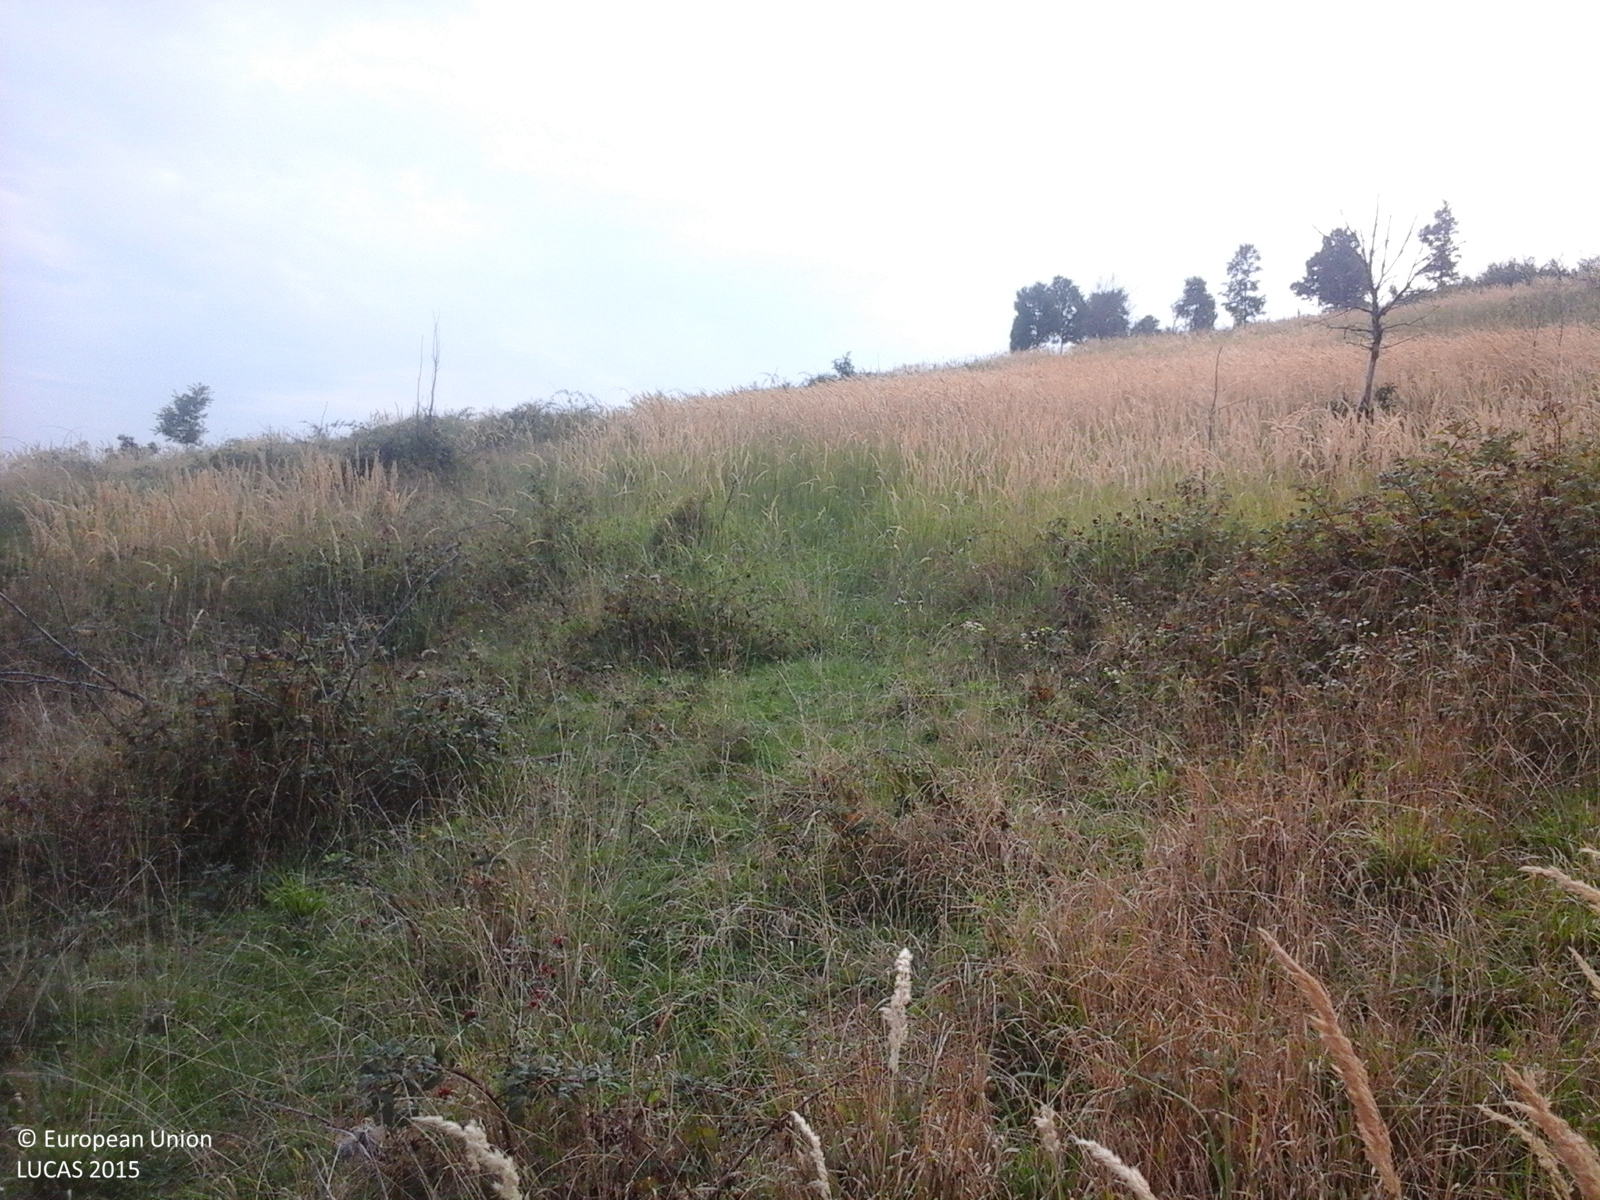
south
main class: Grassland
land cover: Grassland with sparse tree/shrub cover
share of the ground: > 75 %
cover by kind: herbaceous plants 85 %, shrubs 10 %, broadleaved forest trees 5 %
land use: Fallow land
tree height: < 5 m
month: September
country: RO
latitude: 45.7377
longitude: 22.8395
